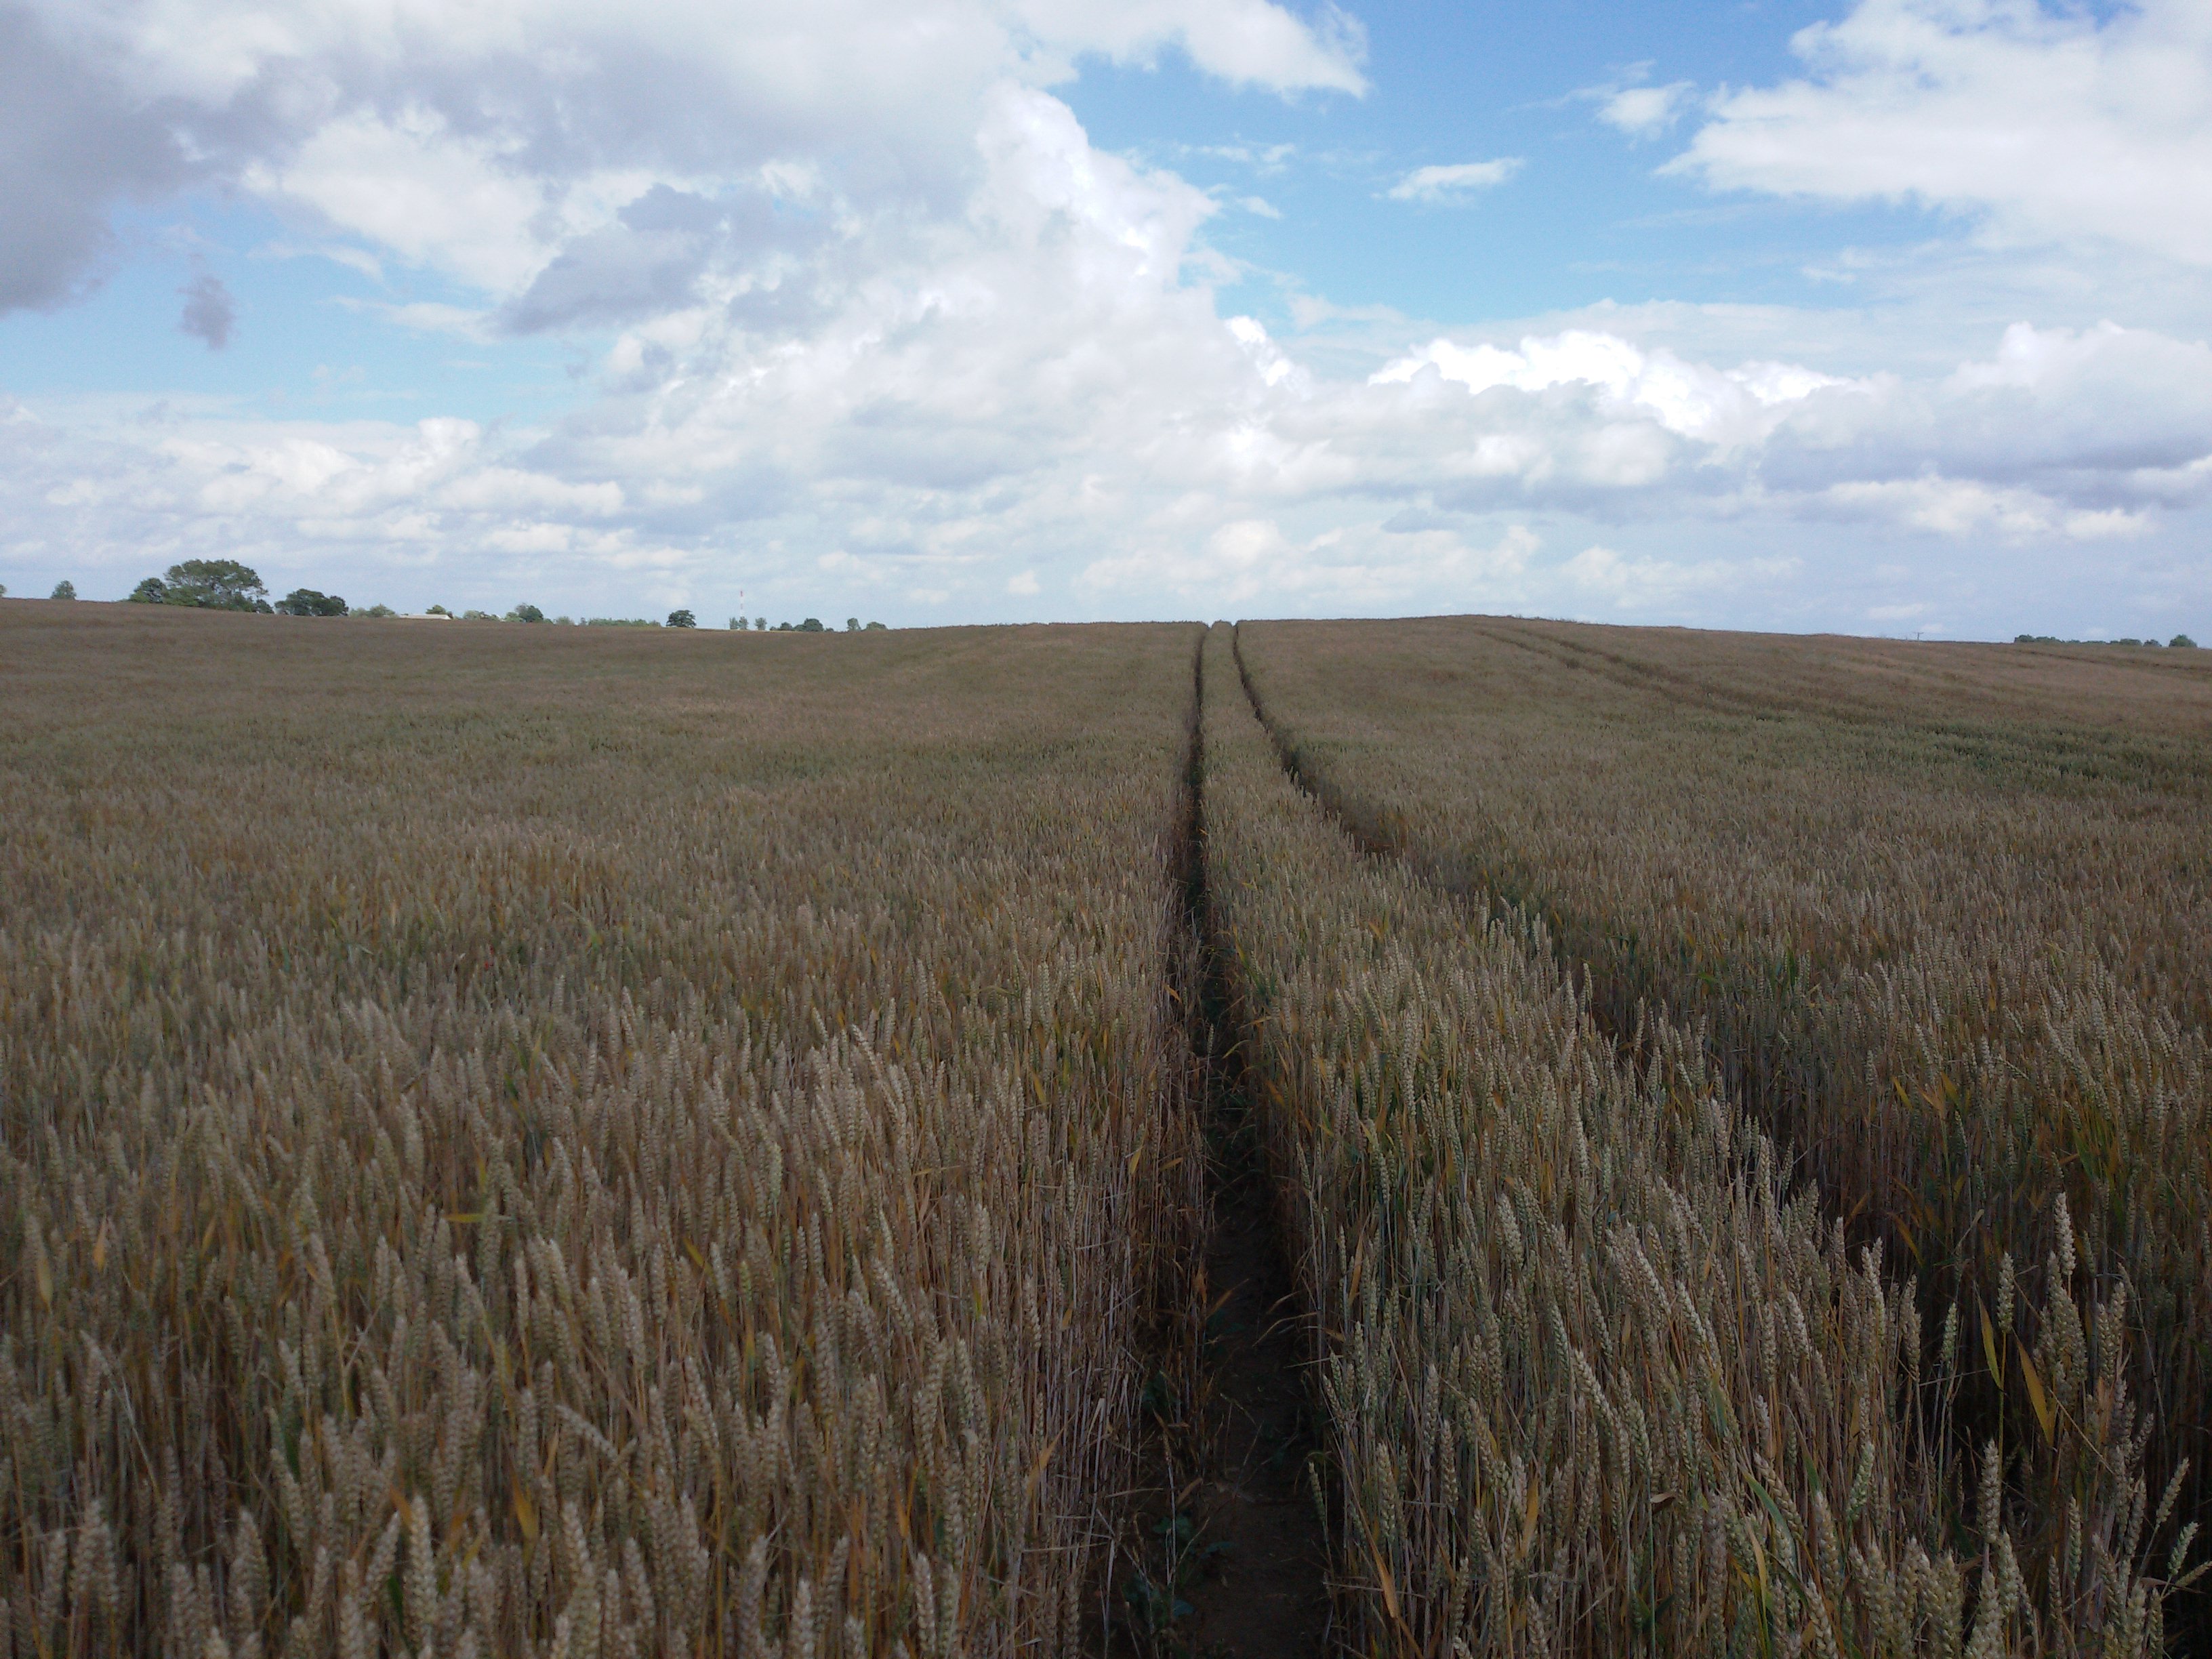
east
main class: Cropland
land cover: Common wheat
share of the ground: > 75 %
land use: Agriculture (excluding fallow land and kitchen gardens)
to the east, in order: Common wheat; Barley
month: July
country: PL
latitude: 52.7863
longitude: 17.5598
